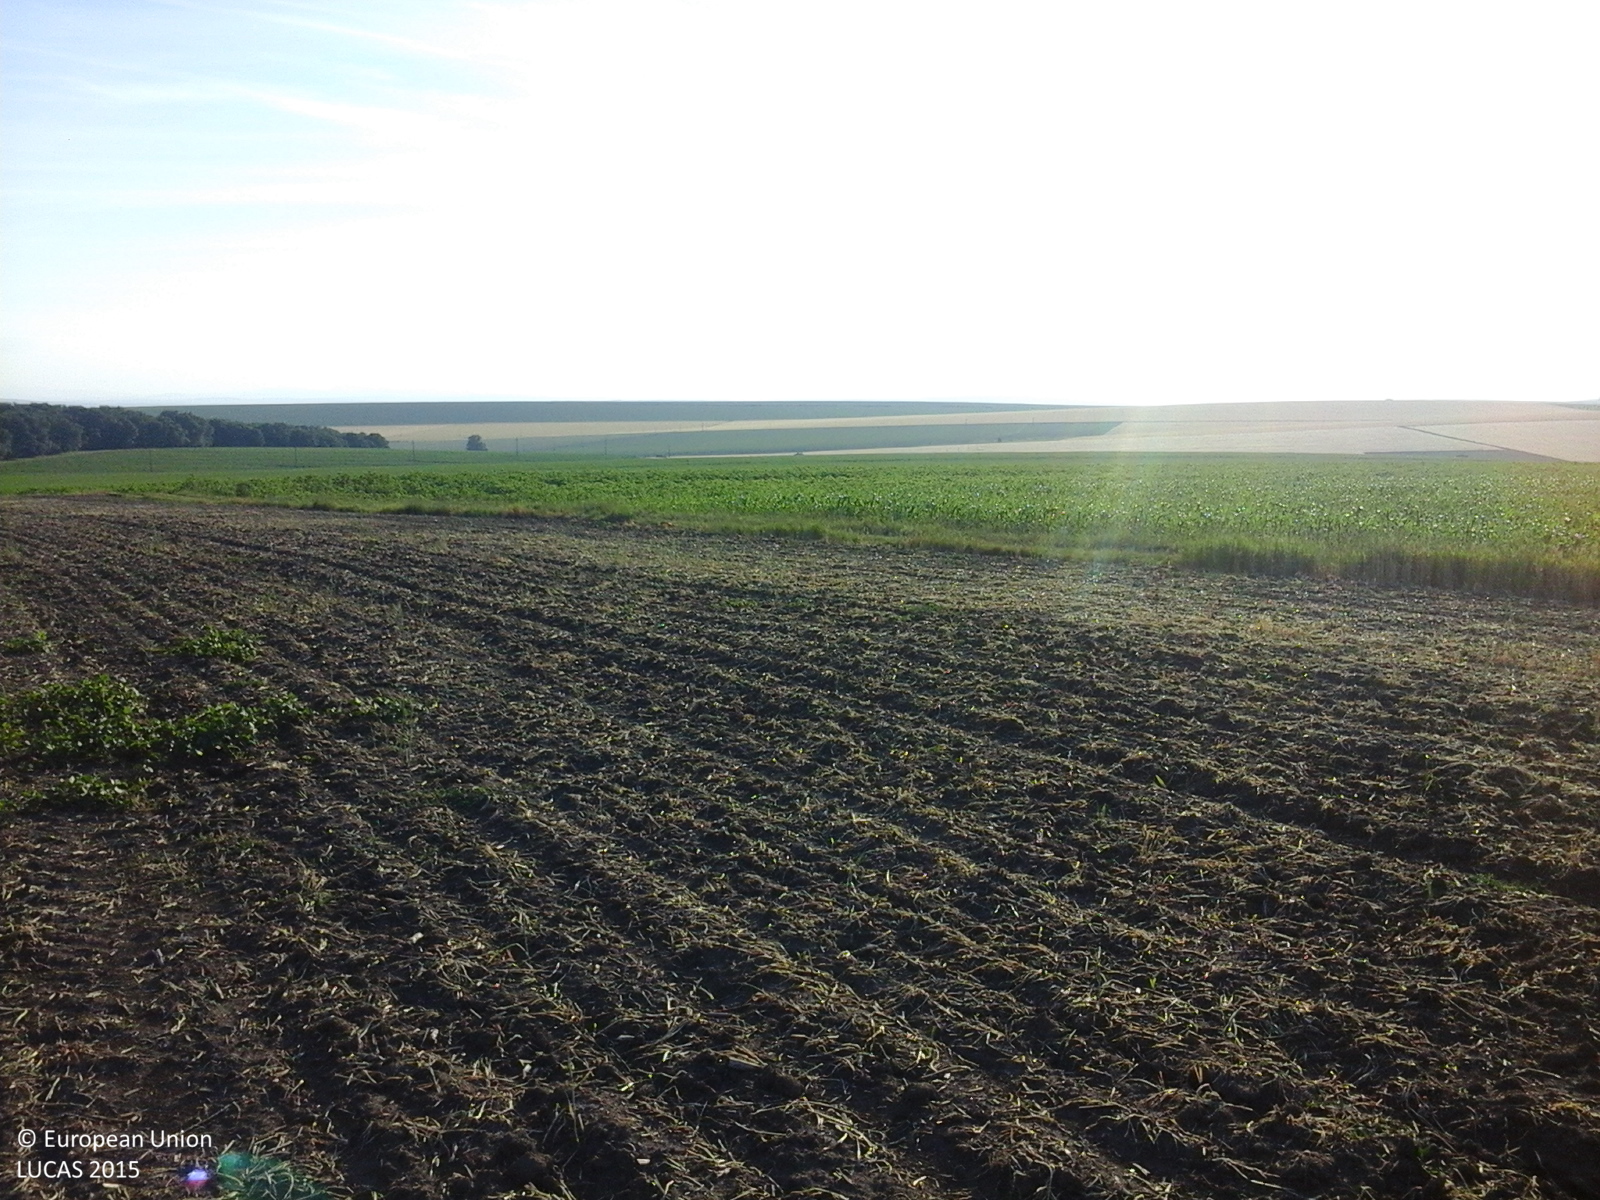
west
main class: Cropland
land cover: Common wheat
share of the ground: < 10 %
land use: Agriculture (excluding fallow land and kitchen gardens)
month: June
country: RO
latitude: 47.0961
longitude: 26.9765
